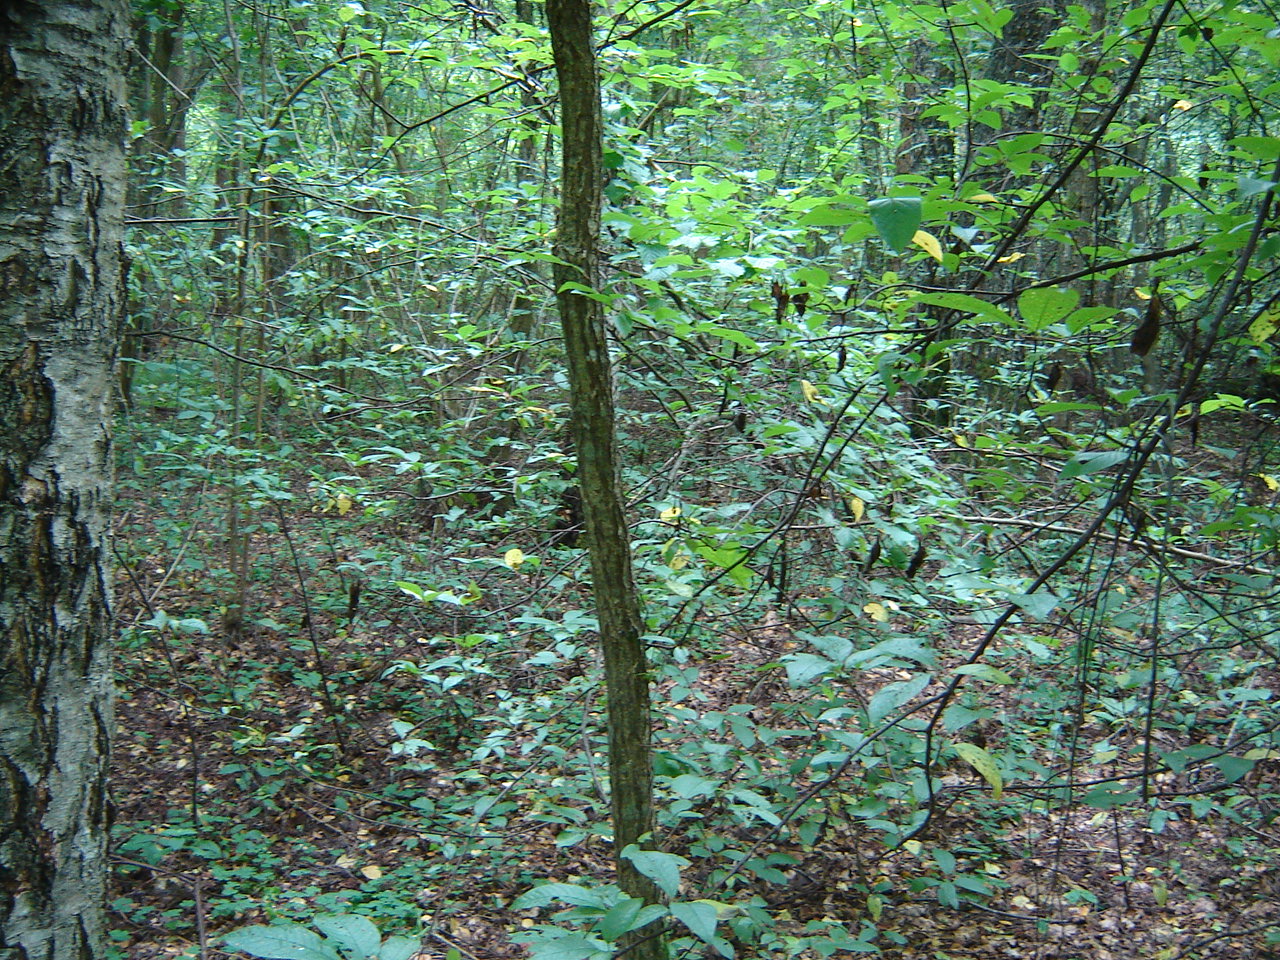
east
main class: Woodland
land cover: Other mixed woodland
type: hemiboreal forest and nemoral coniferous forest and mixed broadleaved-coniferous forest
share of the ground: > 75 %
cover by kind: broadleaved forest trees 50 %, coniferous forest trees 45 %, herbaceous plants 5 %
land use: Forestry
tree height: > 5 m
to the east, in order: Other mixed woodland; Spruce dominated mixed woodland; Other mixed woodland; Grassland without tree/shrub cover; Tracks; Grassland with sparse tree/shrub cover; Broadleaved woodland
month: July
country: LT
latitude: 55.3129
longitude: 25.0342
